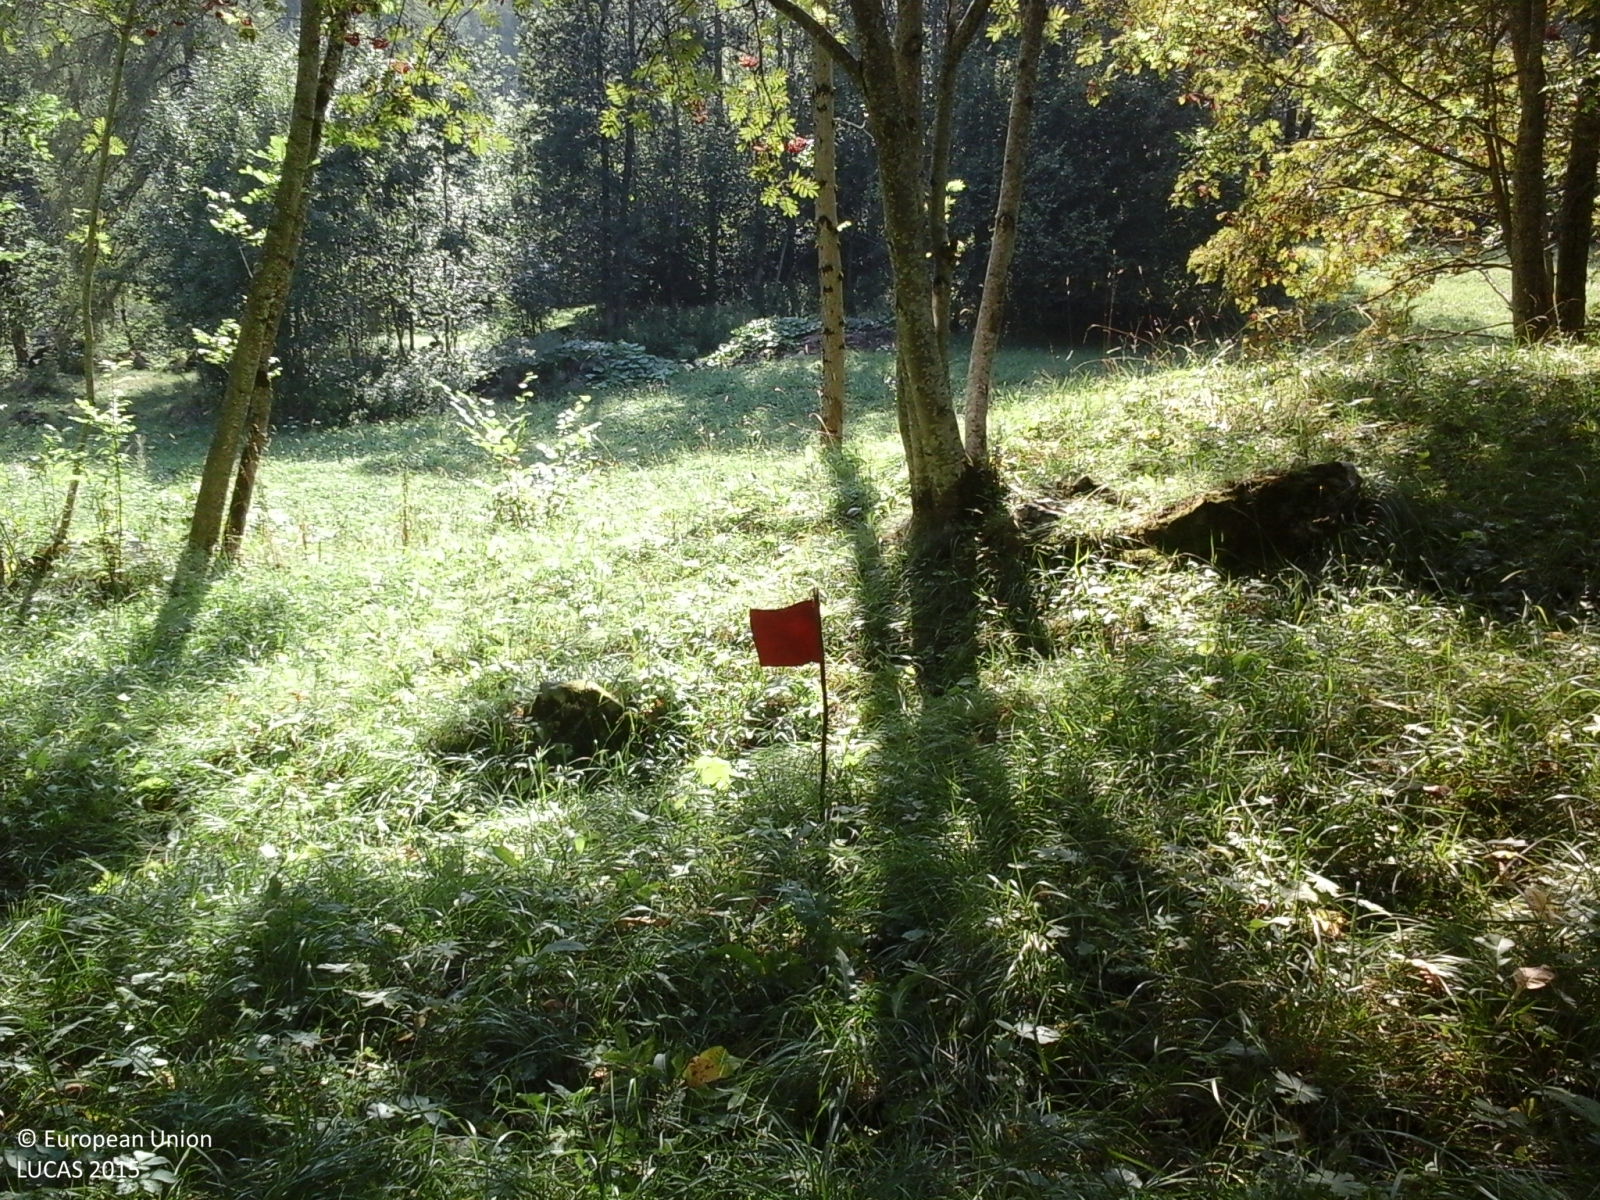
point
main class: Woodland
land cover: Broadleaved woodland
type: thermophilous deciduous forest
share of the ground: > 75 %
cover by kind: broadleaved forest trees 70 %, herbaceous plants 20 %, shrubs 10 %
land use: Forestry
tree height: > 5 m
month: August
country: IT
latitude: 45.6221
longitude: 7.6308
